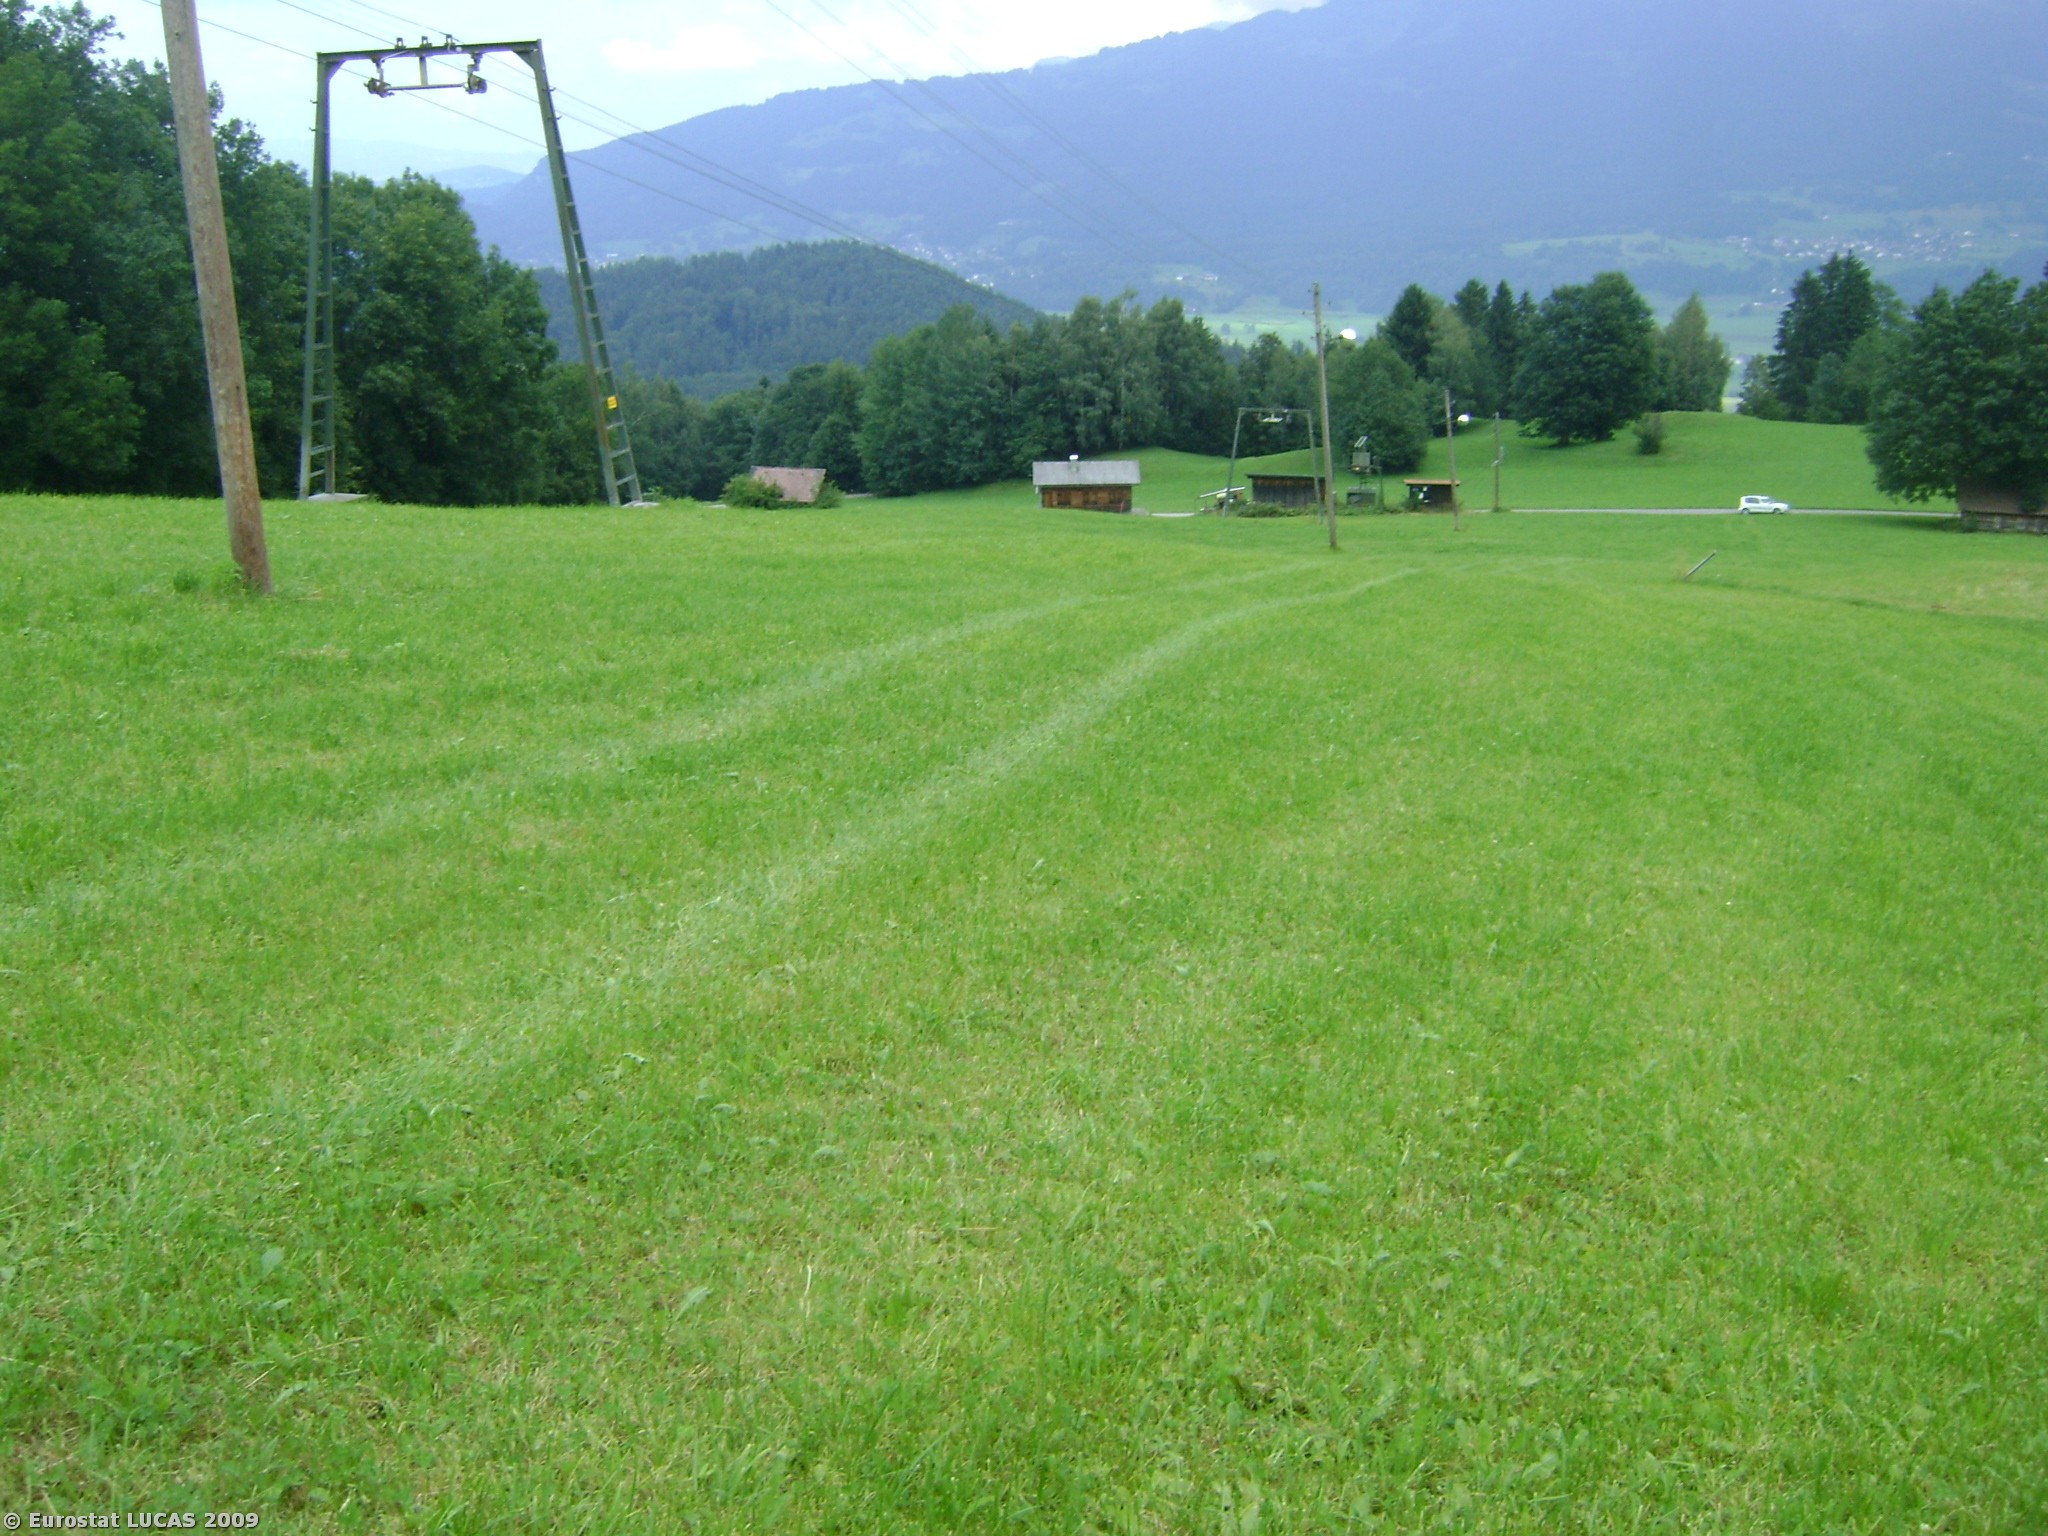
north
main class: Grassland
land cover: Grassland without tree/shrub cover
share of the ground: > 75 %
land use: Agriculture (excluding fallow land and kitchen gardens)
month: August
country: AT
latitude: 47.1791
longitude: 9.6705
